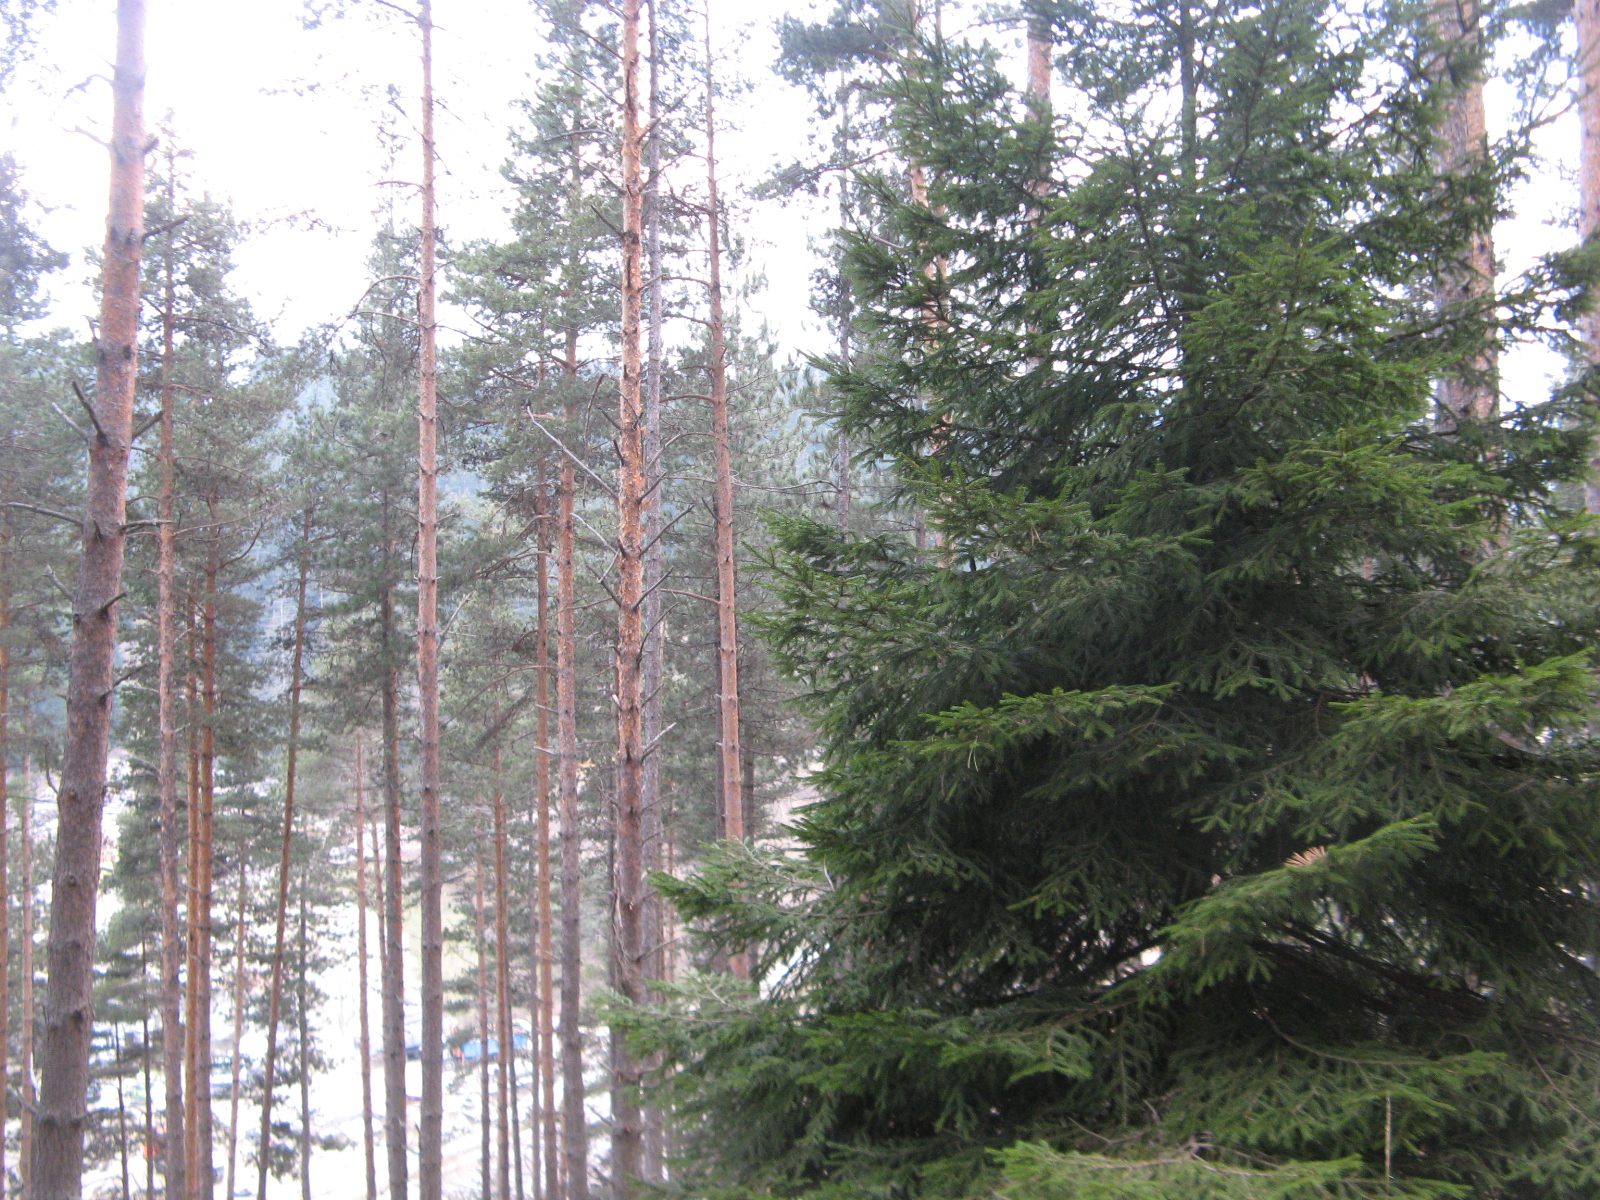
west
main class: Woodland
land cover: Pine dominated coniferous woodland
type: hemiboreal forest and nemoral coniferous forest and mixed broadleaved-coniferous forest
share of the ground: > 75 %
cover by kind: coniferous forest trees 85 %, herbaceous plants 5 %, lichens and mosses 5 %, unconsolidated bare surface 5 %
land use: Forestry
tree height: > 5 m
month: December
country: BG
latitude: 41.6345
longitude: 24.1647
